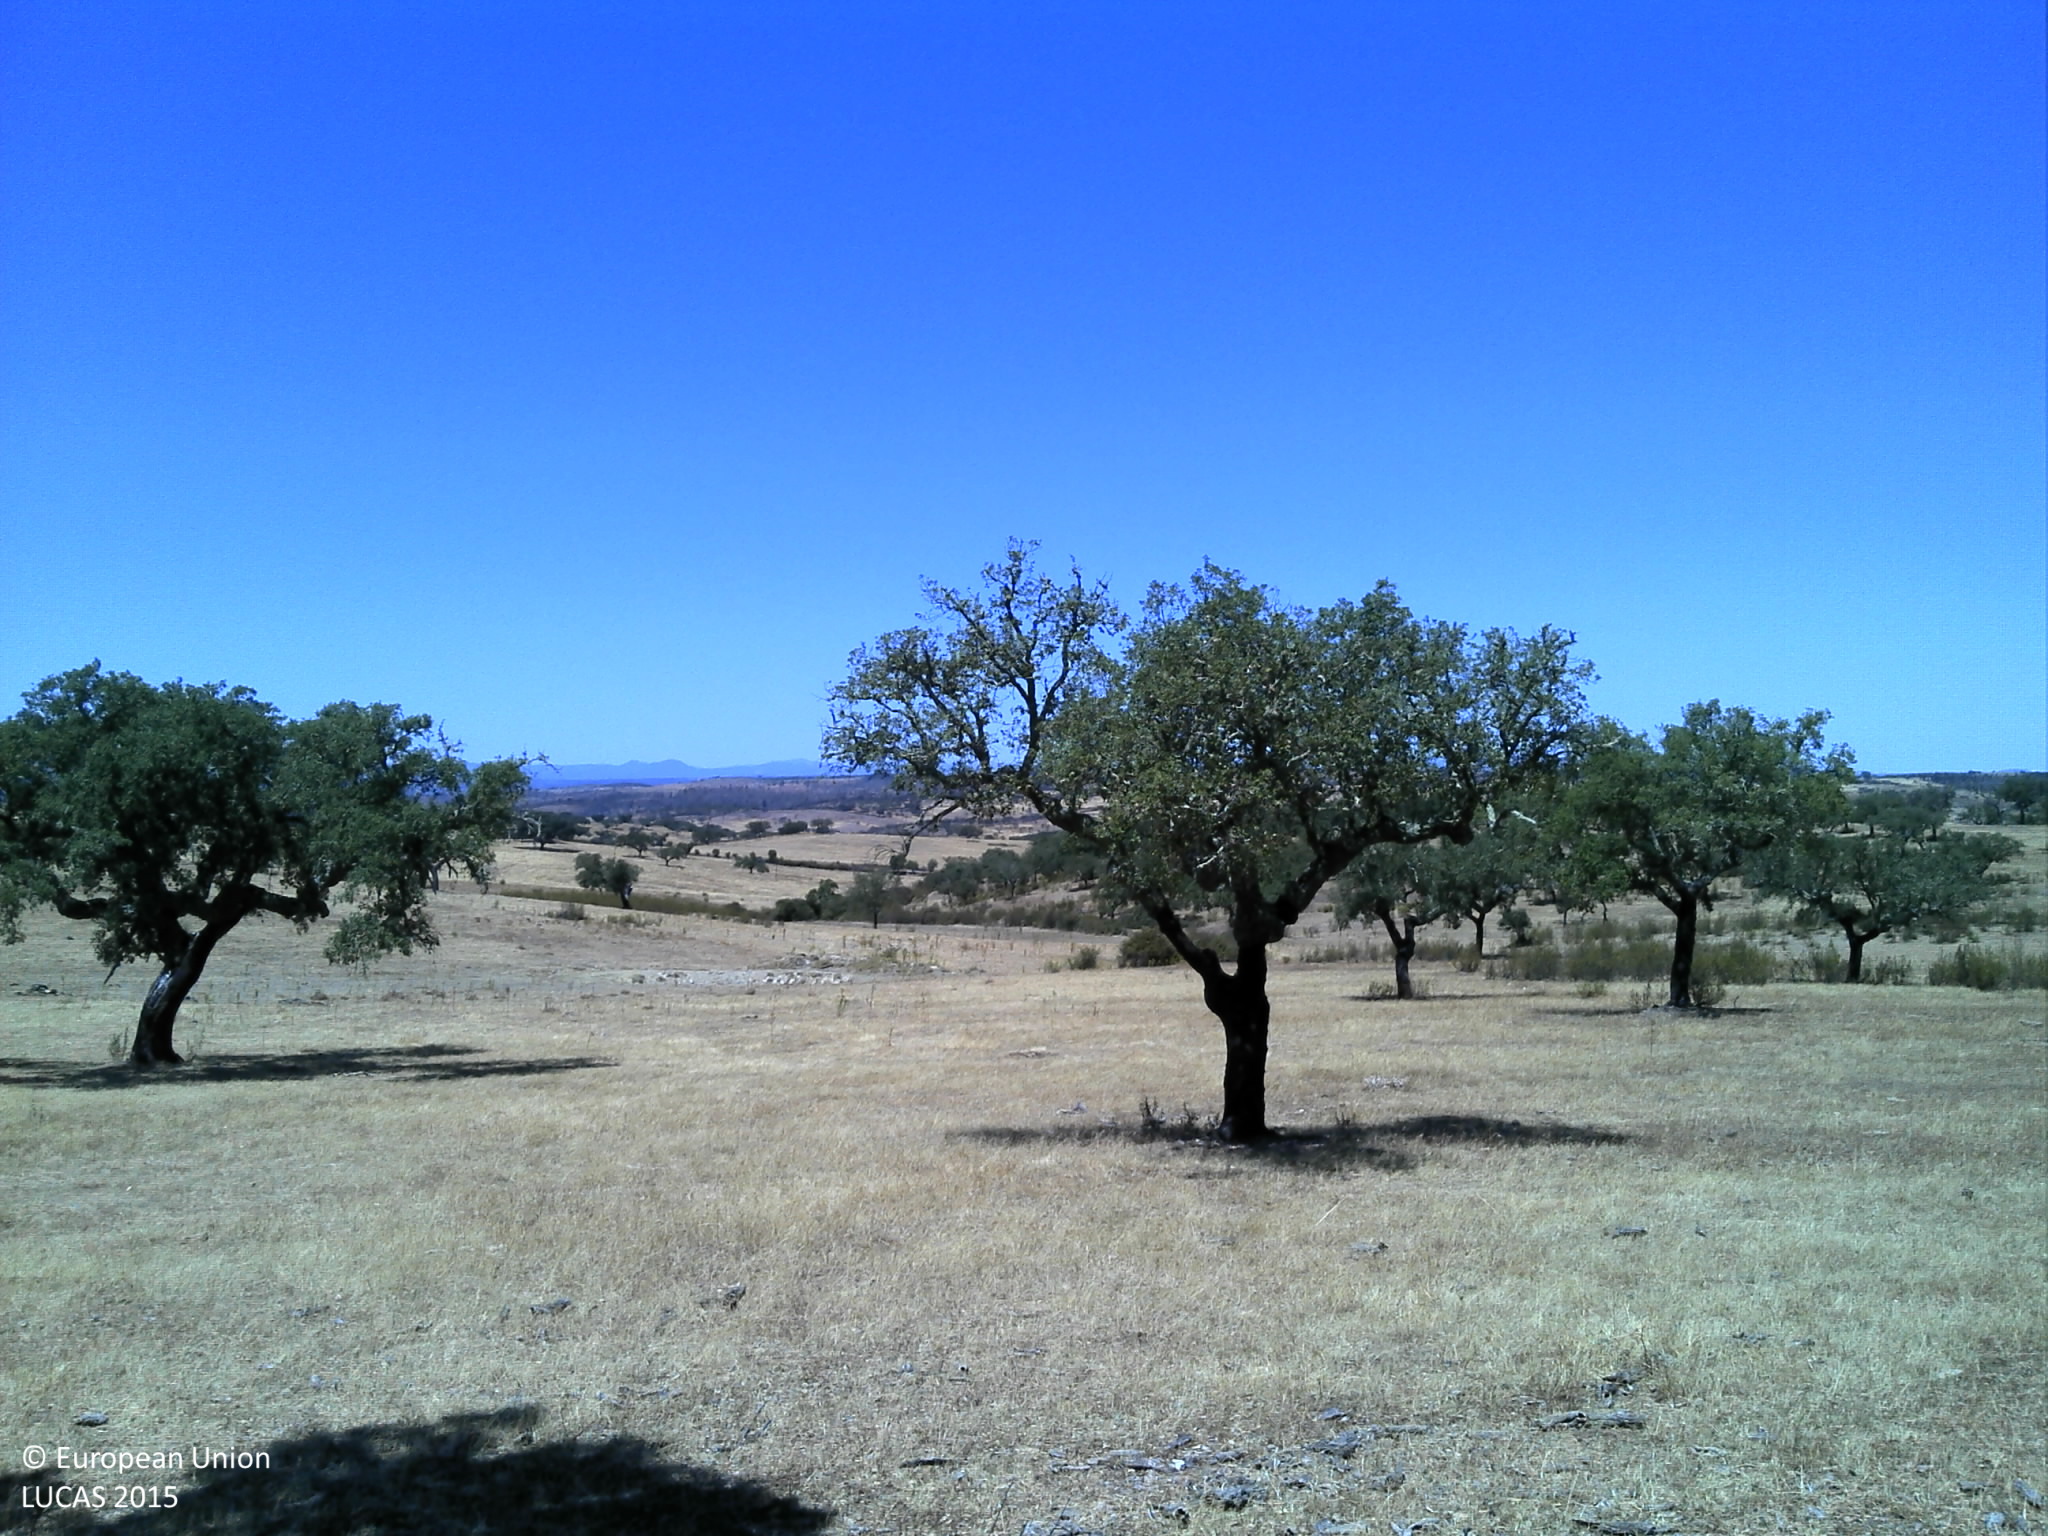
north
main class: Woodland
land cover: Broadleaved woodland
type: broadleaved evergreen forest
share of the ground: 10 - 25 %
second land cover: Grassland without tree/shrub cover
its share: 10 - 25 %
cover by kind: unconsolidated bare surface 80 %, broadleaved forest trees 10 %, herbaceous plants 10 %
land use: Forestry
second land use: Agriculture (excluding fallow land and kitchen gardens)
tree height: > 5 m
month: August
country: PT
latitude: 39.5549
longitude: -7.5647
